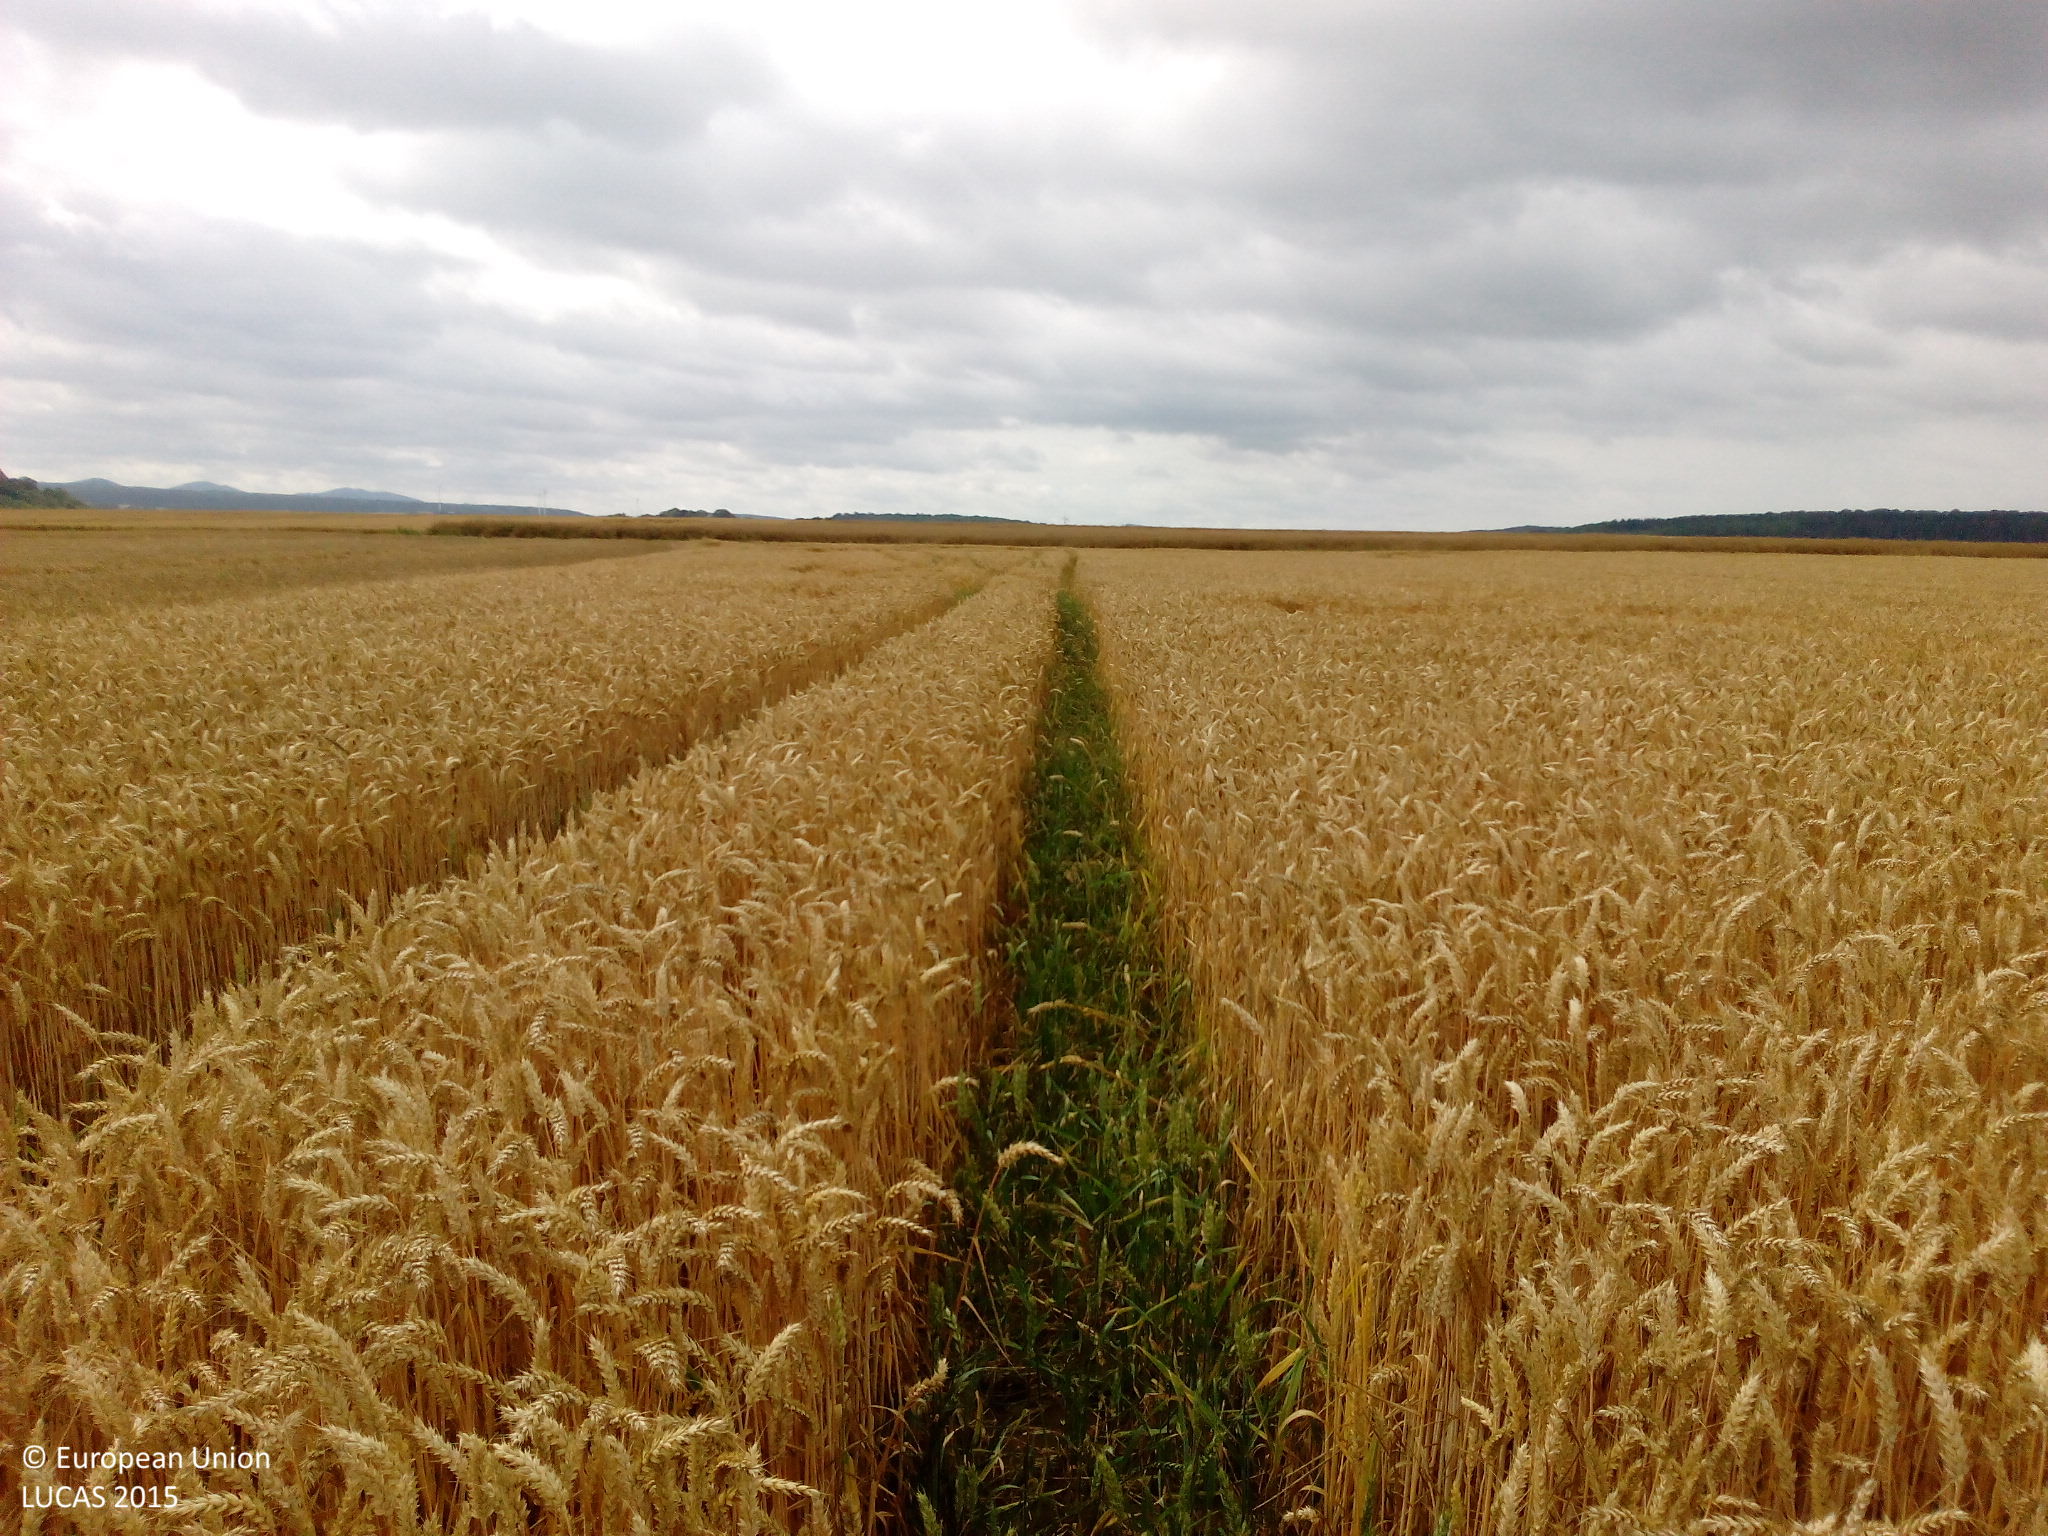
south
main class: Cropland
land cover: Common wheat
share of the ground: > 75 %
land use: Agriculture (excluding fallow land and kitchen gardens)
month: July
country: DE
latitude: 51.4756
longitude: 9.1508
